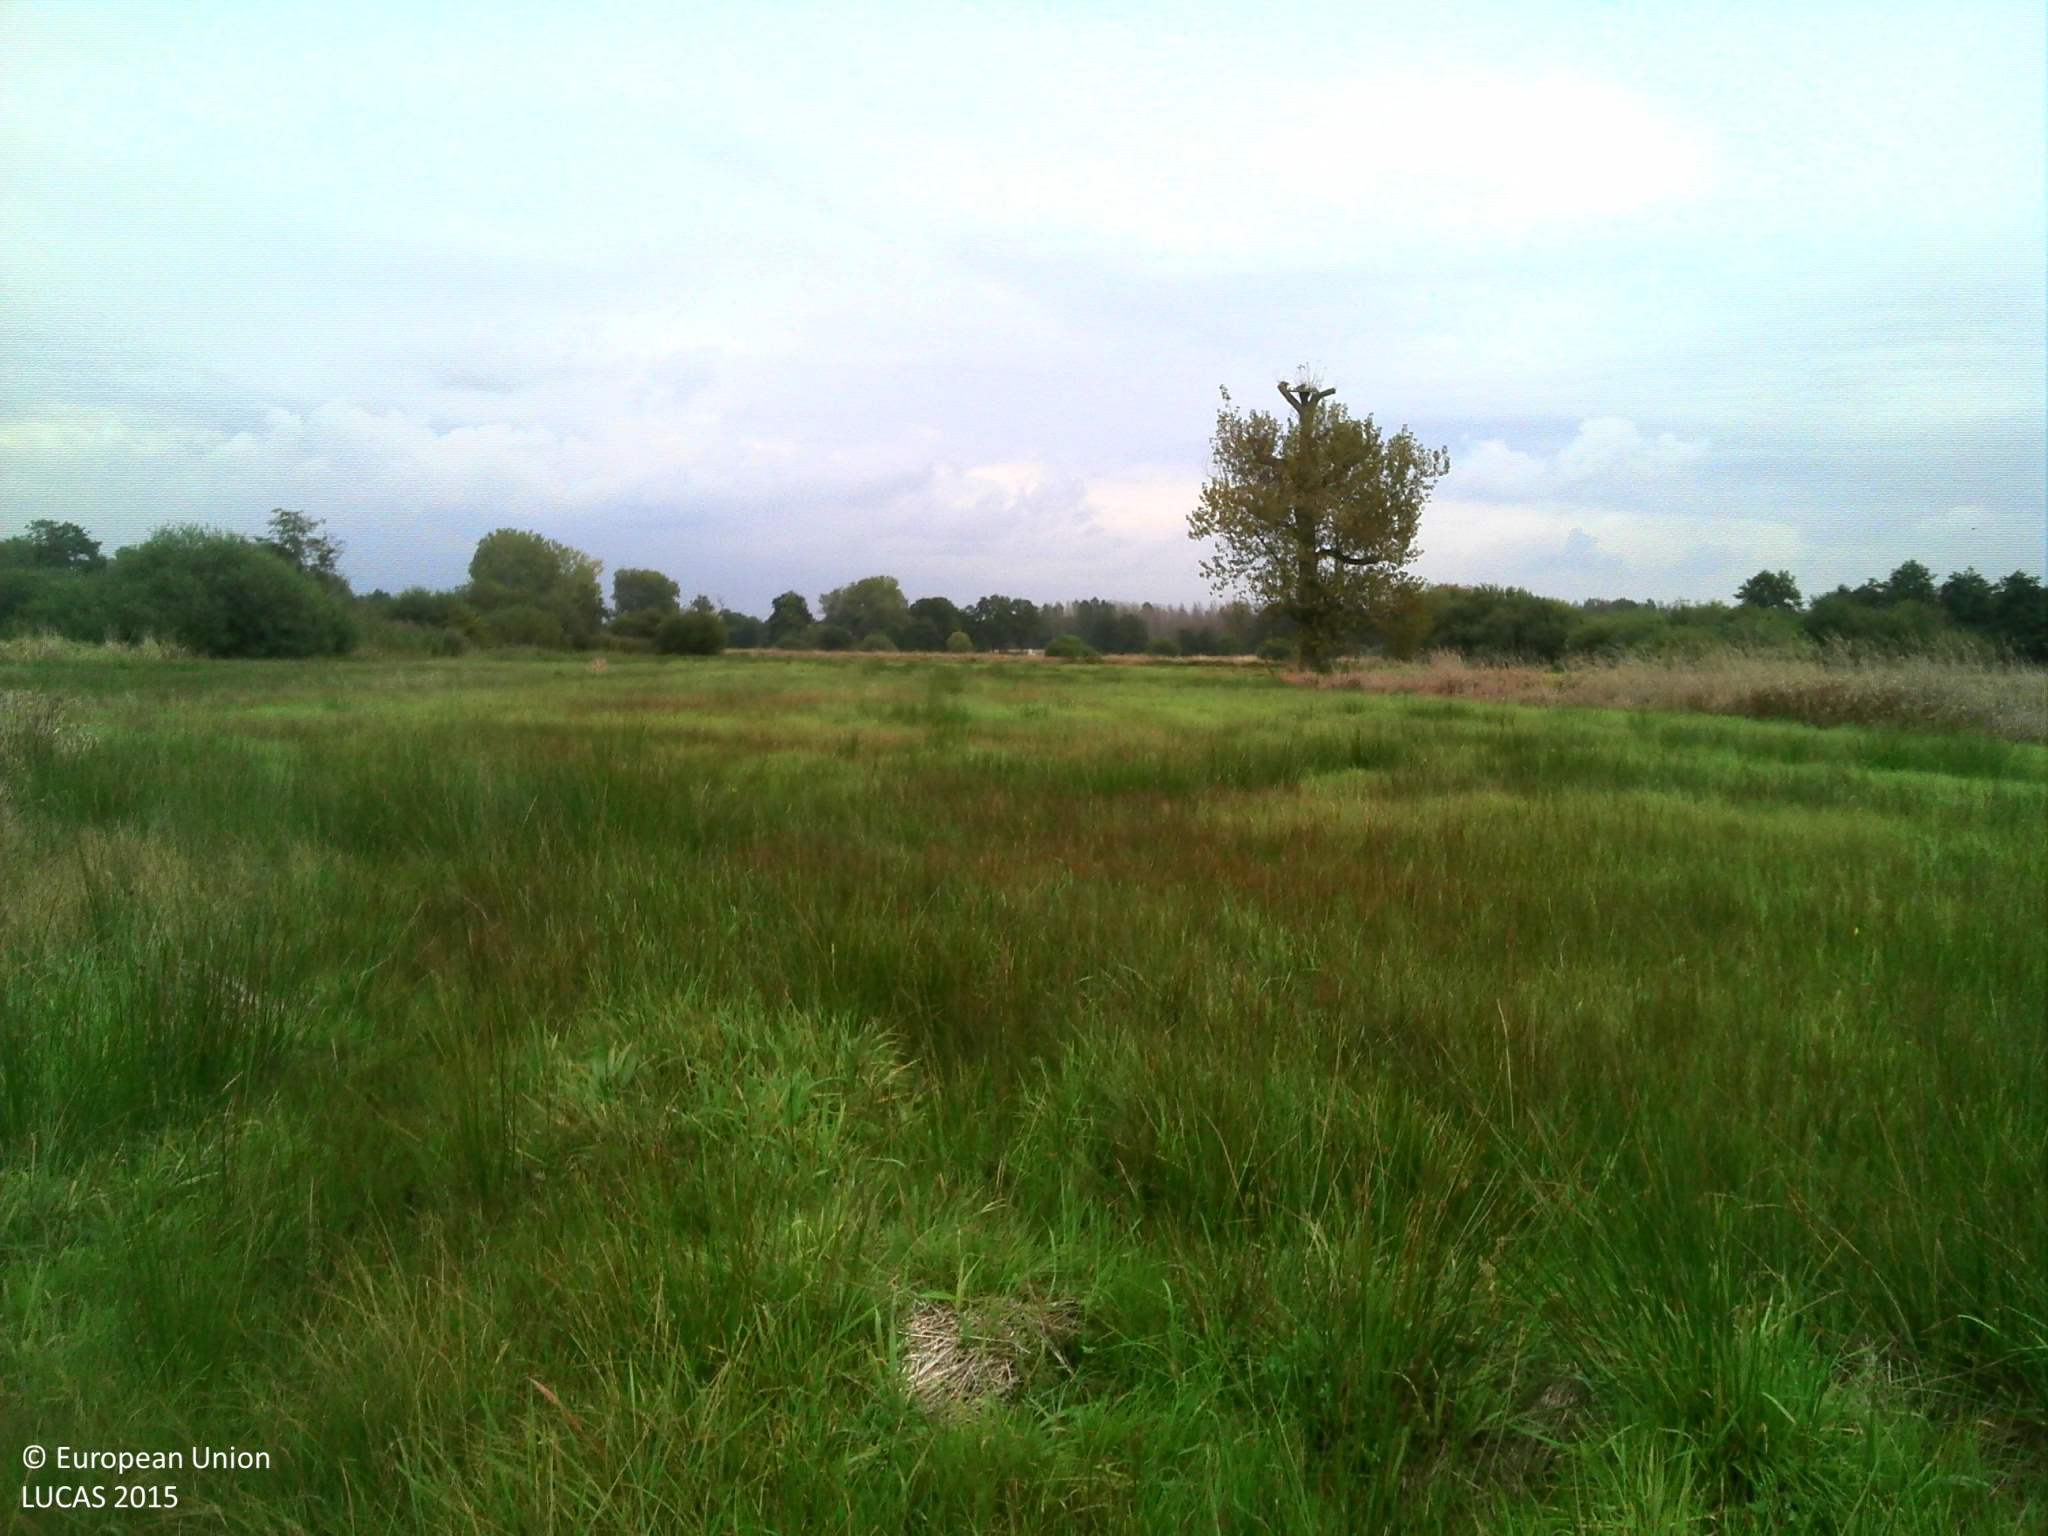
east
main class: Grassland
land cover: Grassland without tree/shrub cover
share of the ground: > 75 %
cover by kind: herbaceous plants 100 %
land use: Agriculture (excluding fallow land and kitchen gardens)
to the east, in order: Grassland without tree/shrub cover; Single bushes/trees; Grassland without tree/shrub cover; Fences; Ditches and canals; Grassland without tree/shrub cover; Grass margins; Grassland without tree/shrub cover
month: October
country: BE
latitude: 51.1451
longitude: 5.1803
